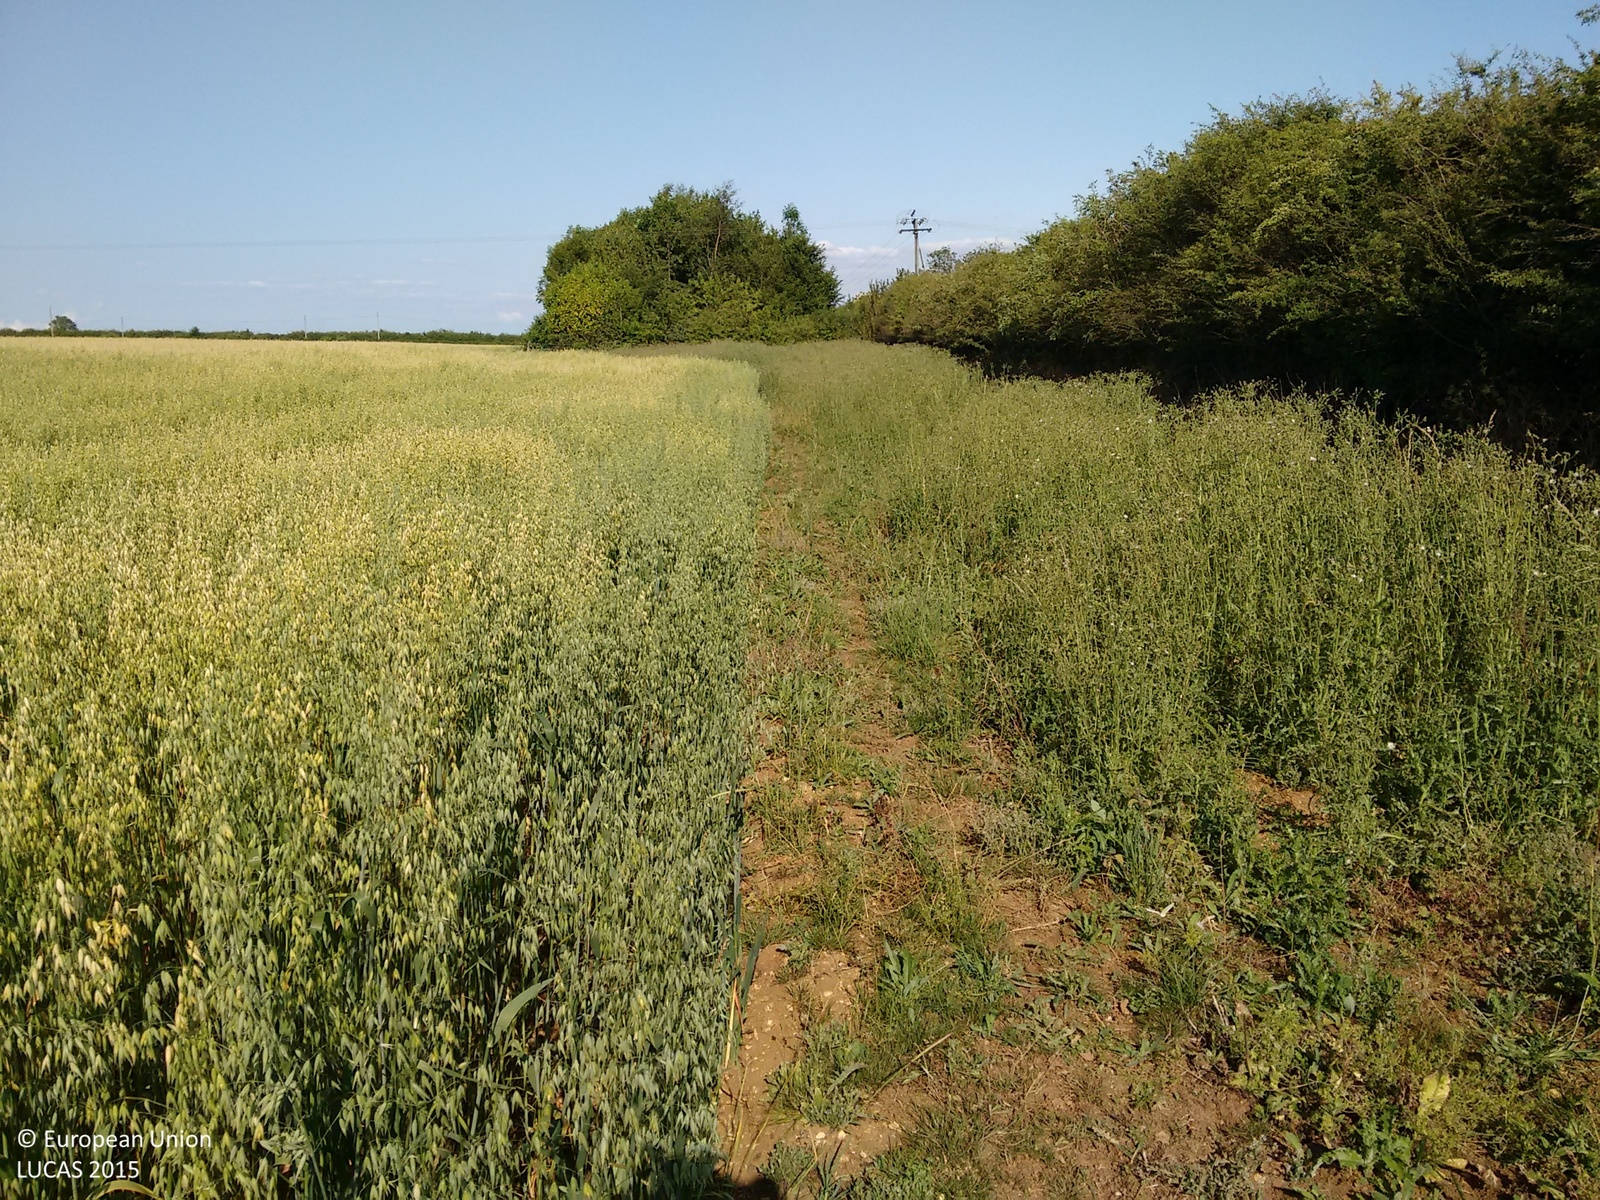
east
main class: Cropland
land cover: Oats
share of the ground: > 75 %
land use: Agriculture (excluding fallow land and kitchen gardens)
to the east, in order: Oats; Electric lines; Oats; Grass margins; Ditches and canals; Fences; Broadleaved woodland
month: July
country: GB
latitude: 52.7056
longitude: -0.5315
